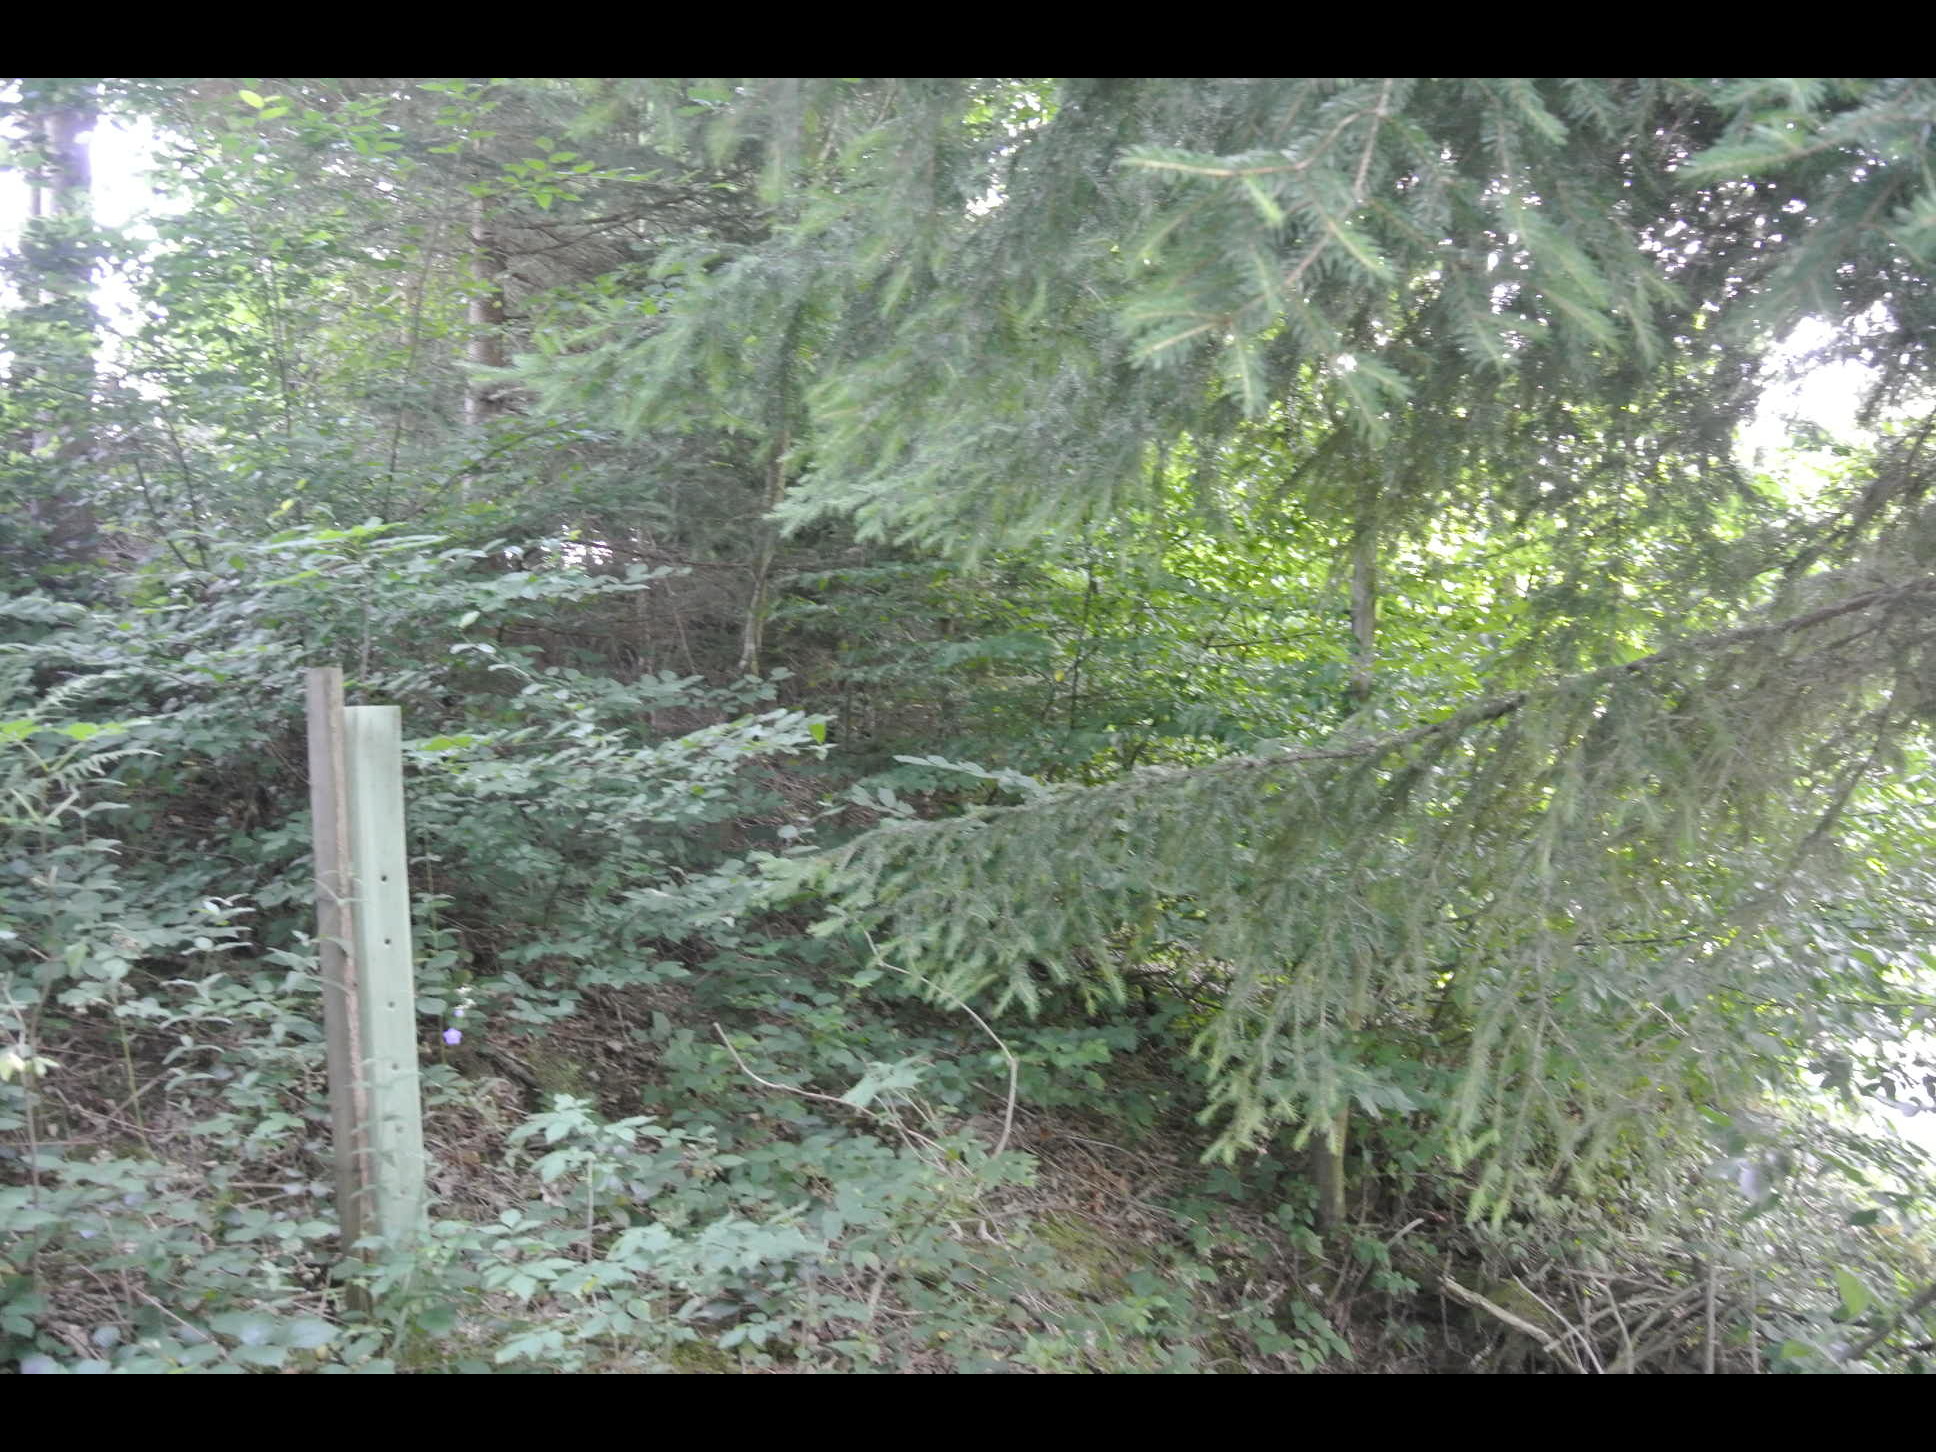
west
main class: Woodland
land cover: Spruce dominated mixed woodland
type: alpine coniferous forest
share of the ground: > 75 %
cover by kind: coniferous forest trees 70 %, broadleaved forest trees 30 %
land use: Forestry
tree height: > 5 m
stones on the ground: < 10 %
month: July
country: AT
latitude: 47.6568
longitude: 16.1144
